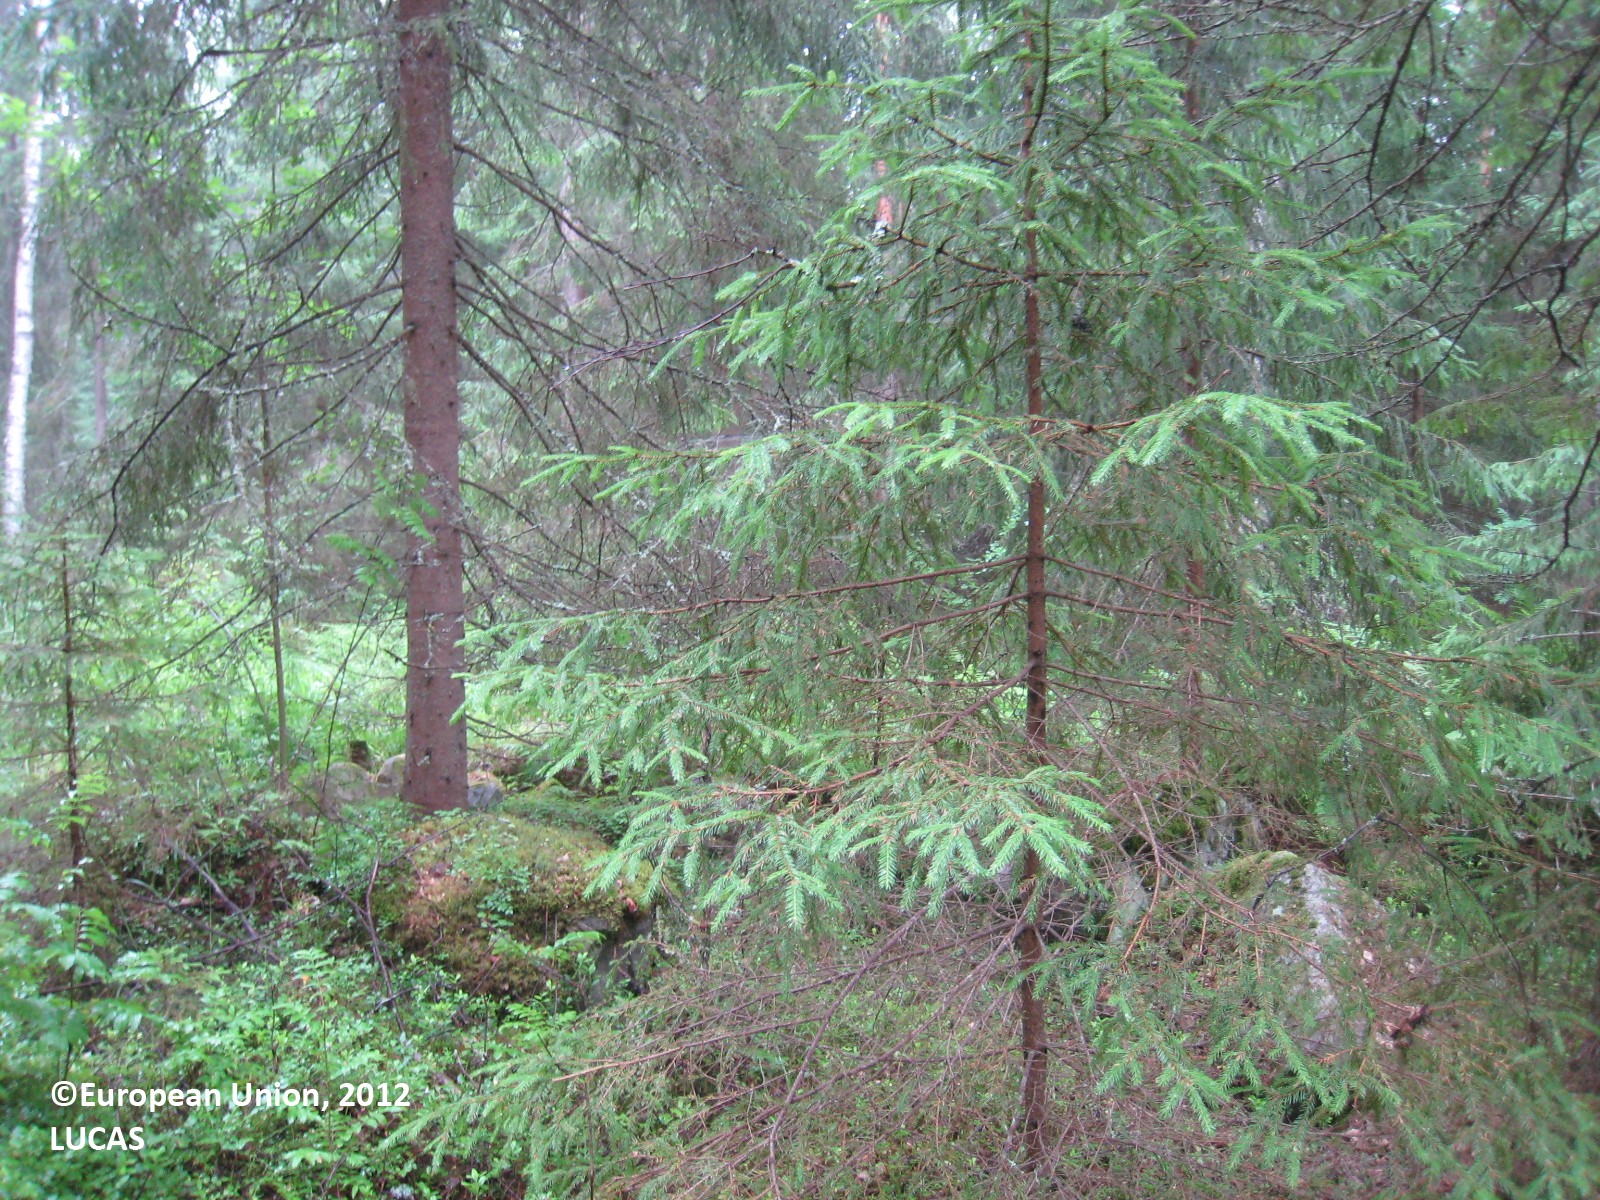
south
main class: Woodland
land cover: Spruce dominated mixed woodland
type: boreal forest
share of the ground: 50 - 75 %
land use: Forestry
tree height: > 5 m
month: July
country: FI
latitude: 61.7807
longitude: 27.0131
